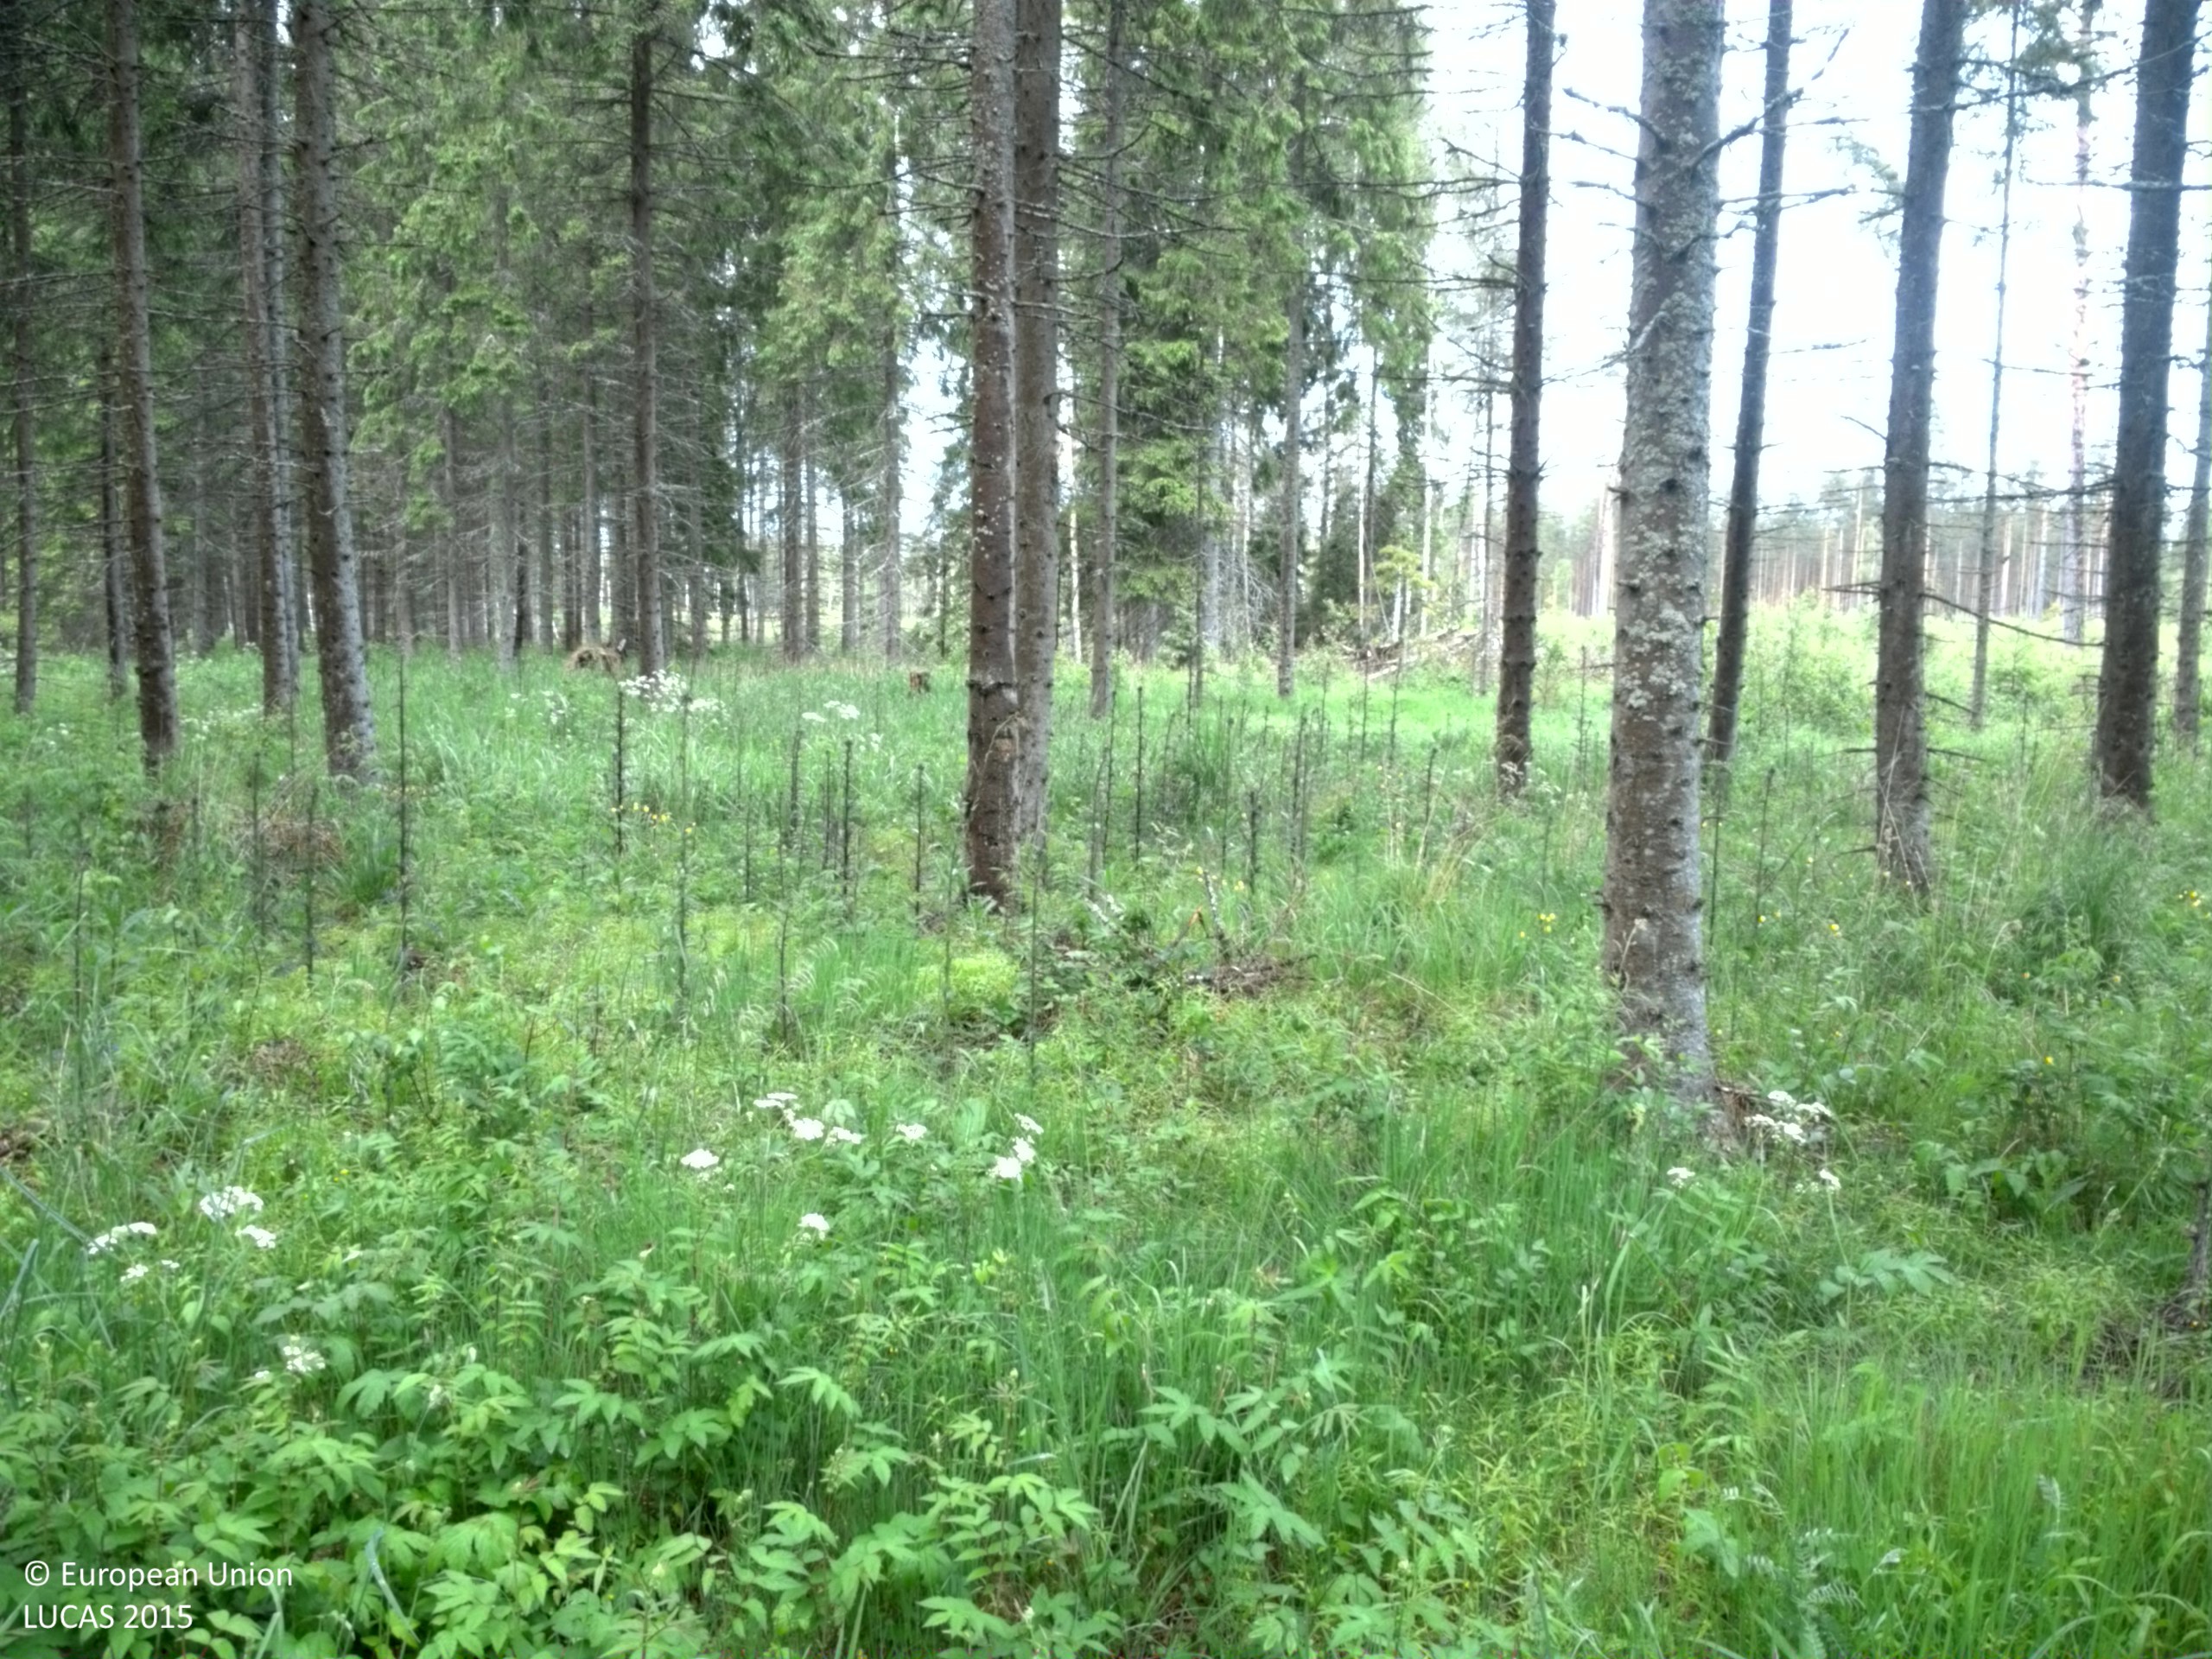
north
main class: Woodland
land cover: Spruce dominated coniferous woodland
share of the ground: 25 - 50 %
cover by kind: herbaceous plants 50 %, coniferous forest trees 40 %, lichens and mosses 5 %, consolidated bare surface 5 %
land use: Forestry
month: June
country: SE
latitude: 60.3307
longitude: 17.7260
